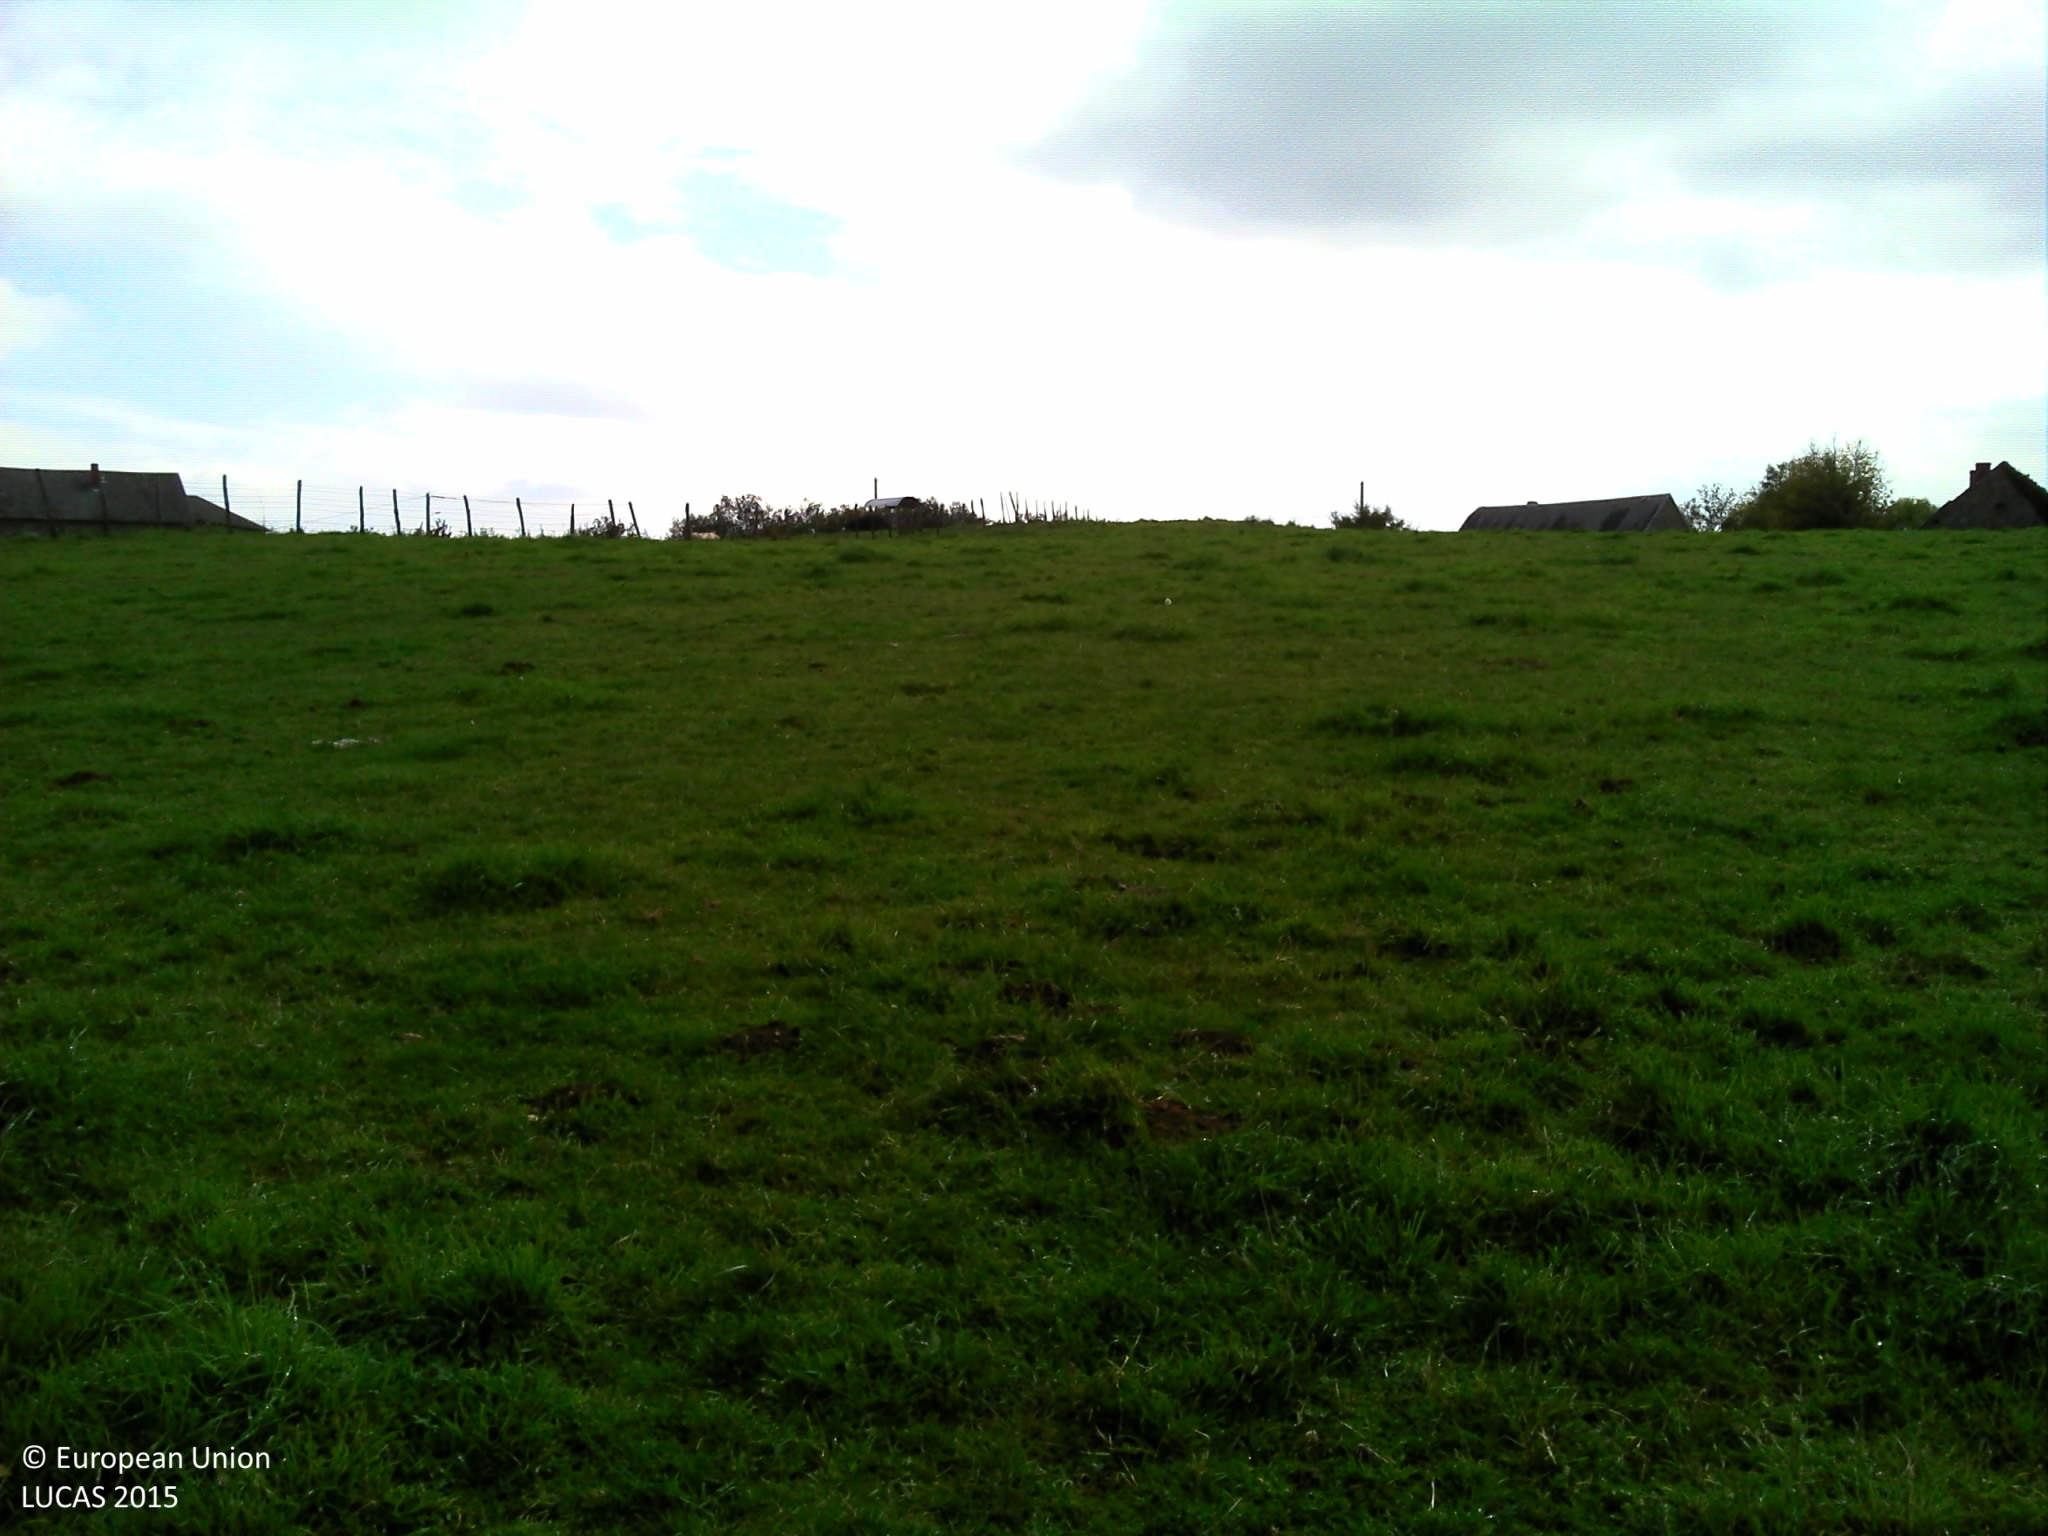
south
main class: Grassland
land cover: Grassland without tree/shrub cover
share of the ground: > 75 %
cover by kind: herbaceous plants 100 %
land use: Agriculture (excluding fallow land and kitchen gardens)
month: October
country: FR
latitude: 46.0737
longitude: 2.8218
